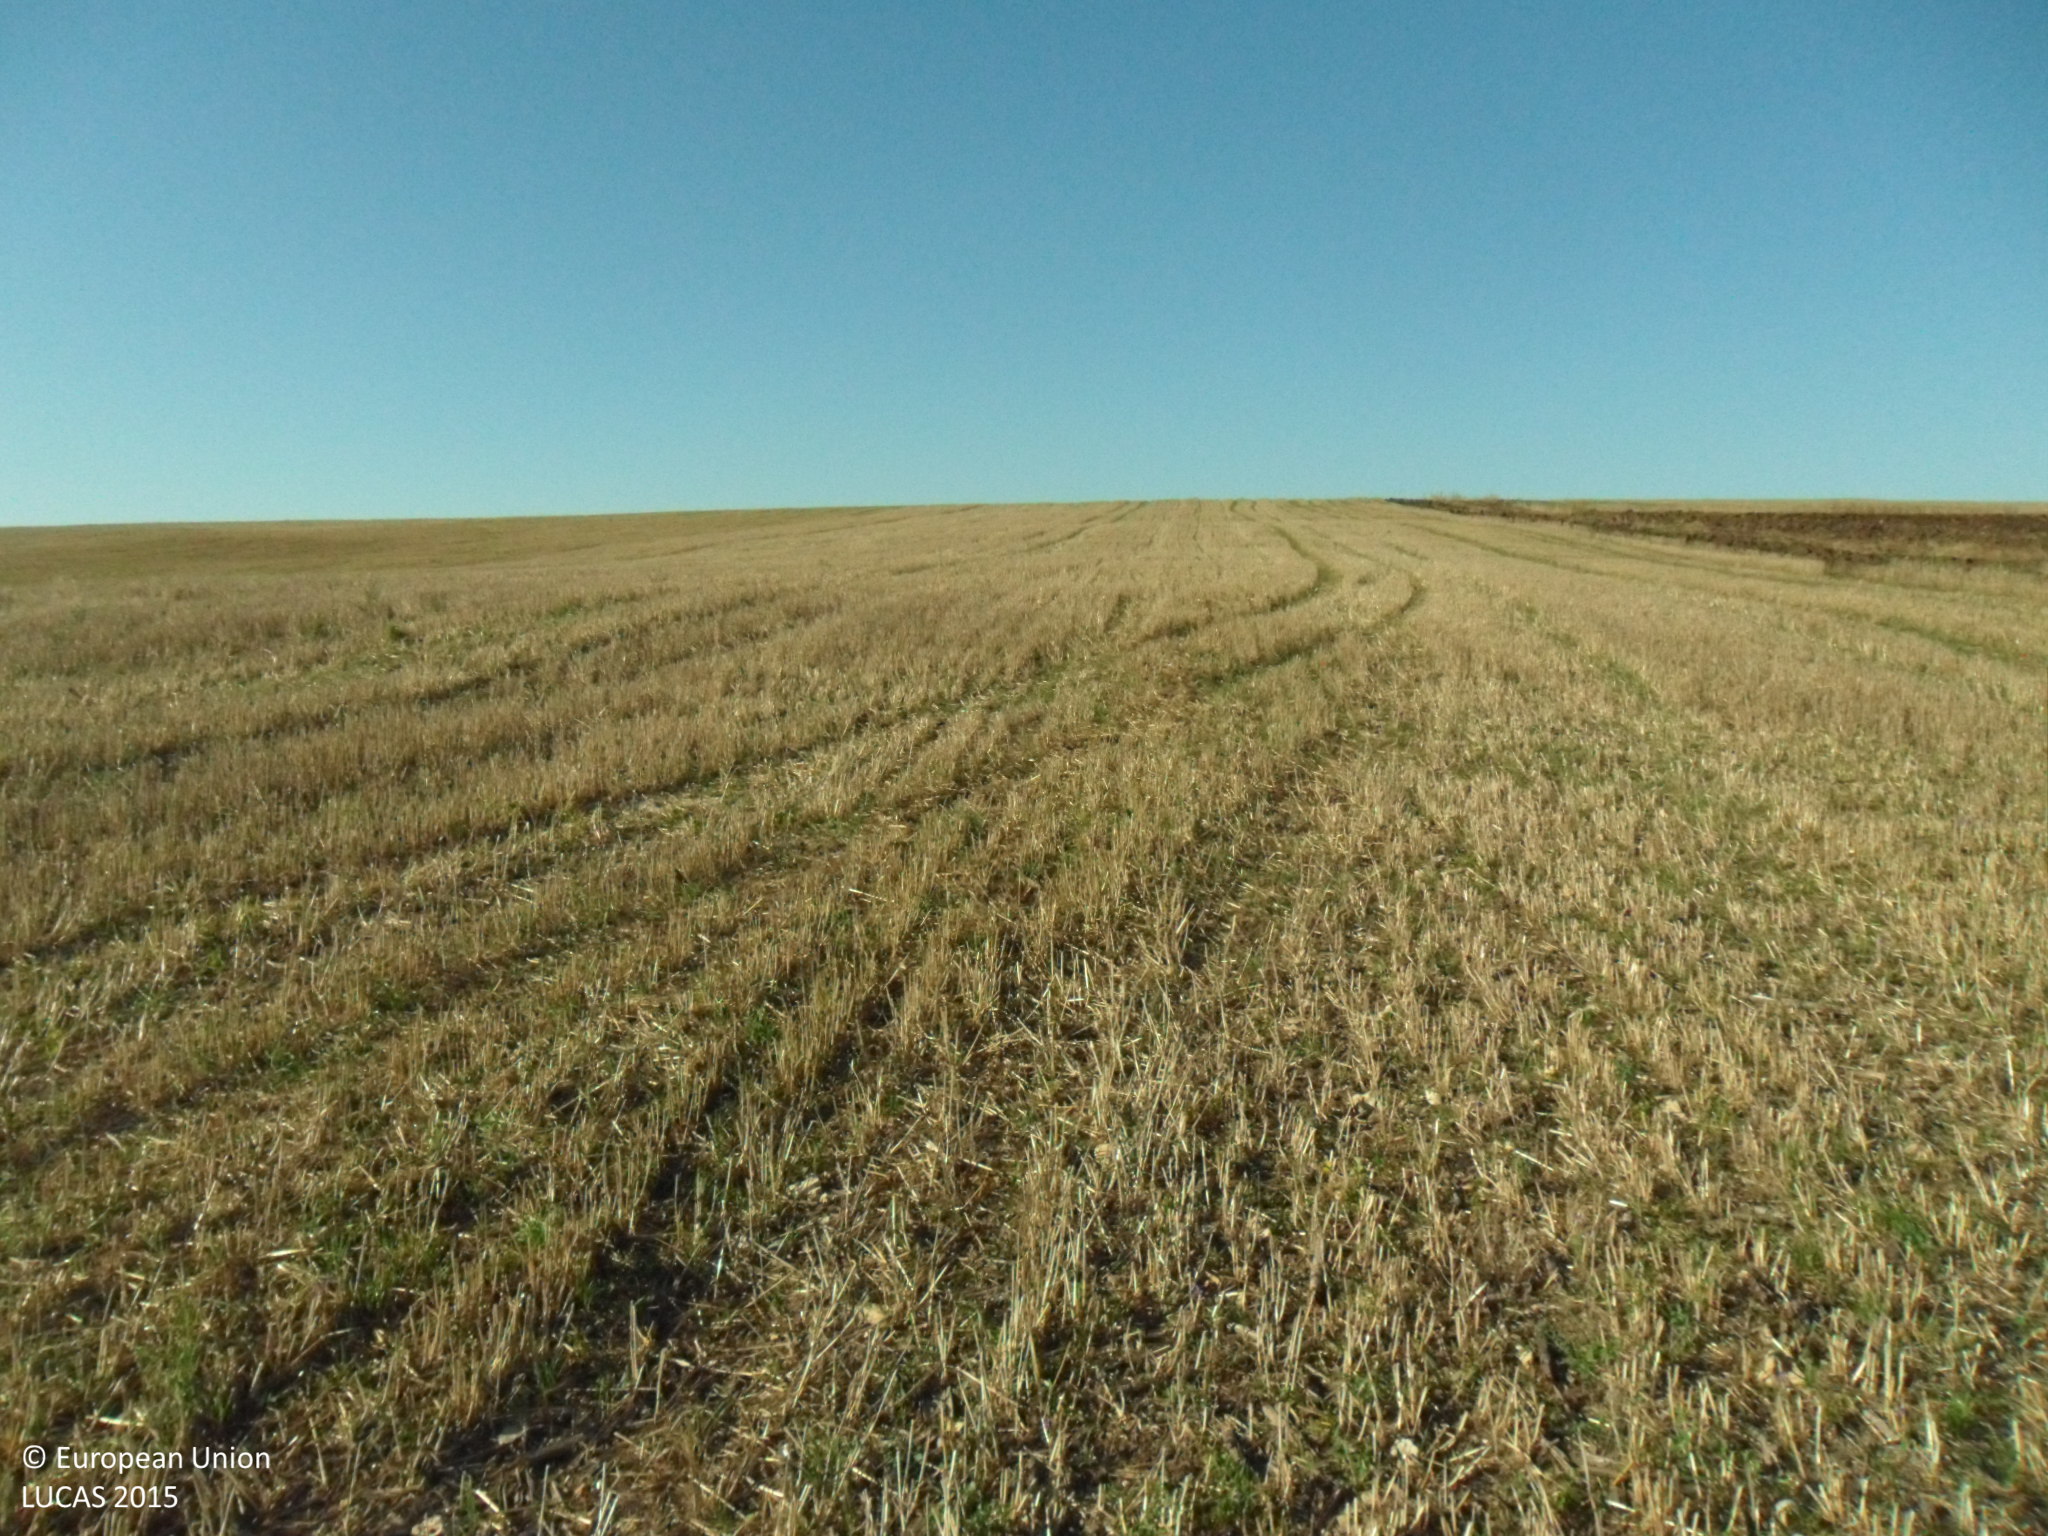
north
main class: Cropland
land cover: Common wheat
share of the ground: 10 - 25 %
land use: Agriculture (excluding fallow land and kitchen gardens)
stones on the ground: < 10 %
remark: Harvested field
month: September
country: BG
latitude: 43.2154
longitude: 27.1927
